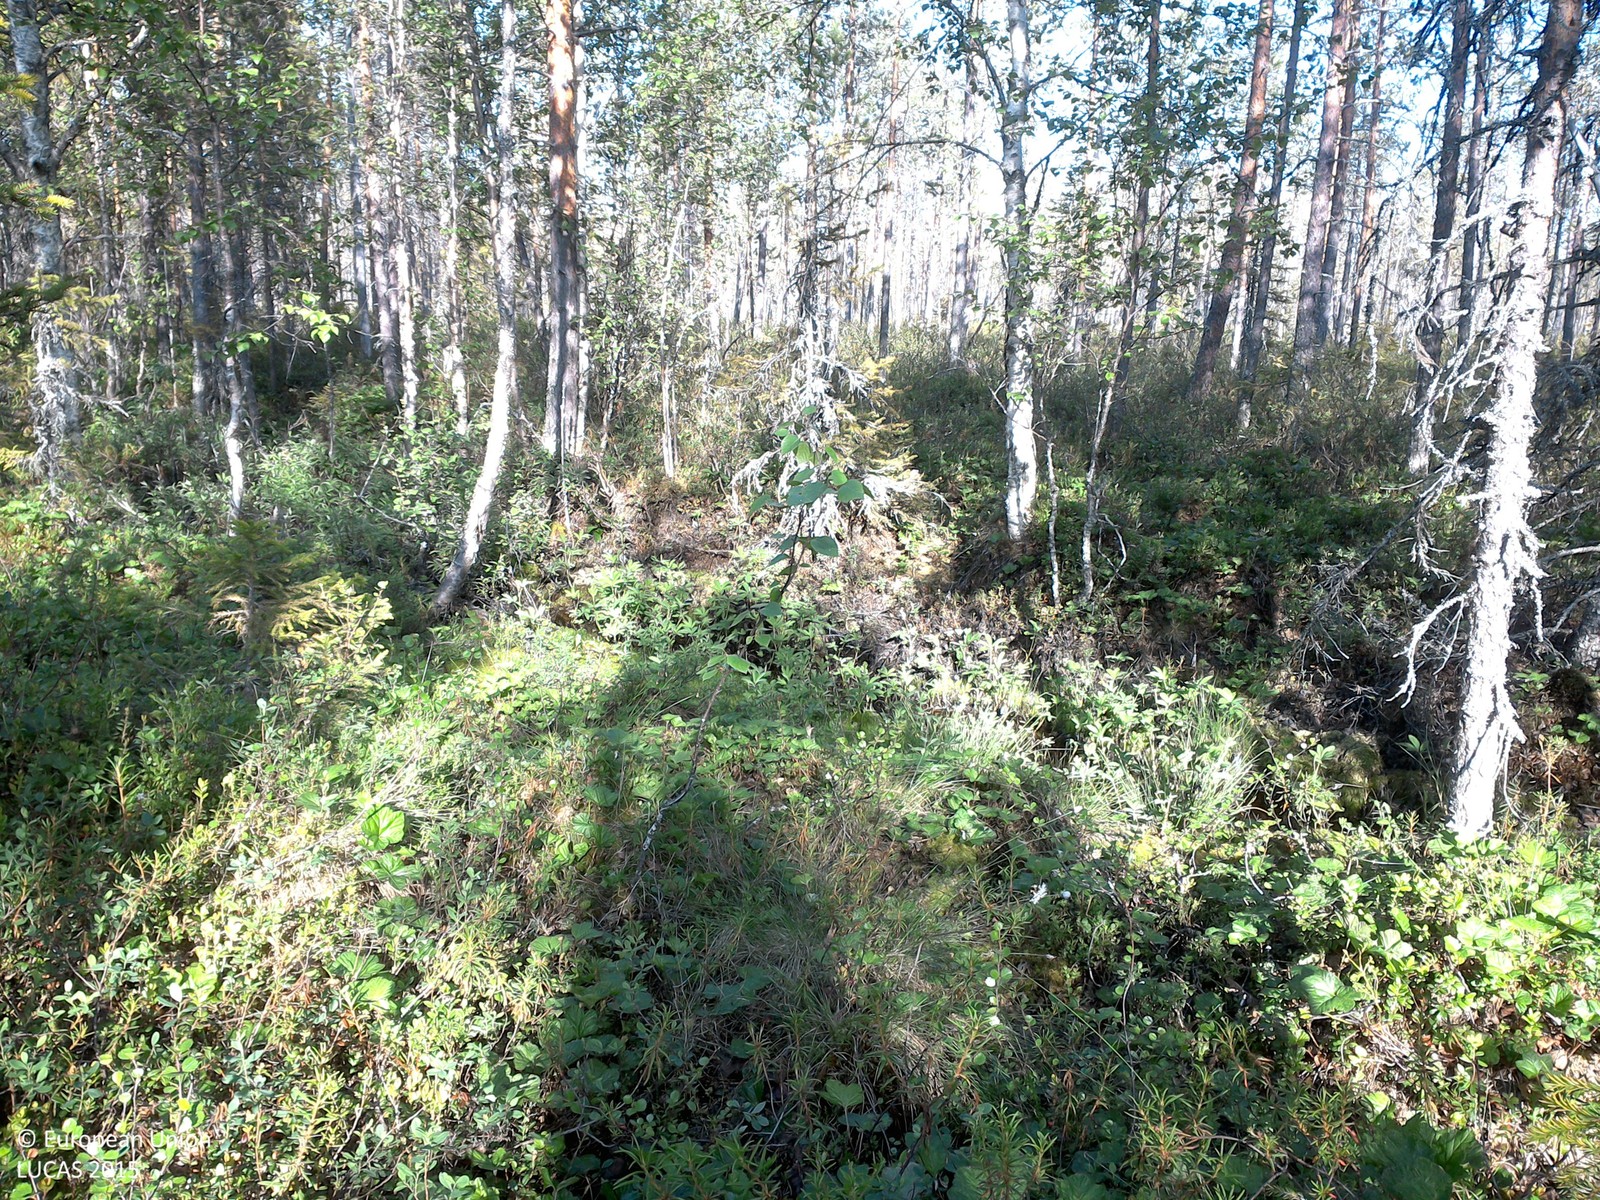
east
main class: Woodland
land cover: Pine dominated mixed woodland
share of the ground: 10 - 25 %
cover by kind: shrubs 45 %, herbaceous plants 20 %, coniferous forest trees 15 %, lichens and mosses 15 %, broadleaved forest trees 5 %
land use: Forestry
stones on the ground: < 10 %
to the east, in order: Pine dominated mixed woodland; Ditches and canals; Pine dominated mixed woodland; Pine dominated coniferous woodland; Pine dominated mixed woodland; Ditches and canals; Pine dominated mixed woodland; Pine dominated coniferous woodland; Shrubland without tree cover
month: July
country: SE
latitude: 67.2667
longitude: 22.6938
